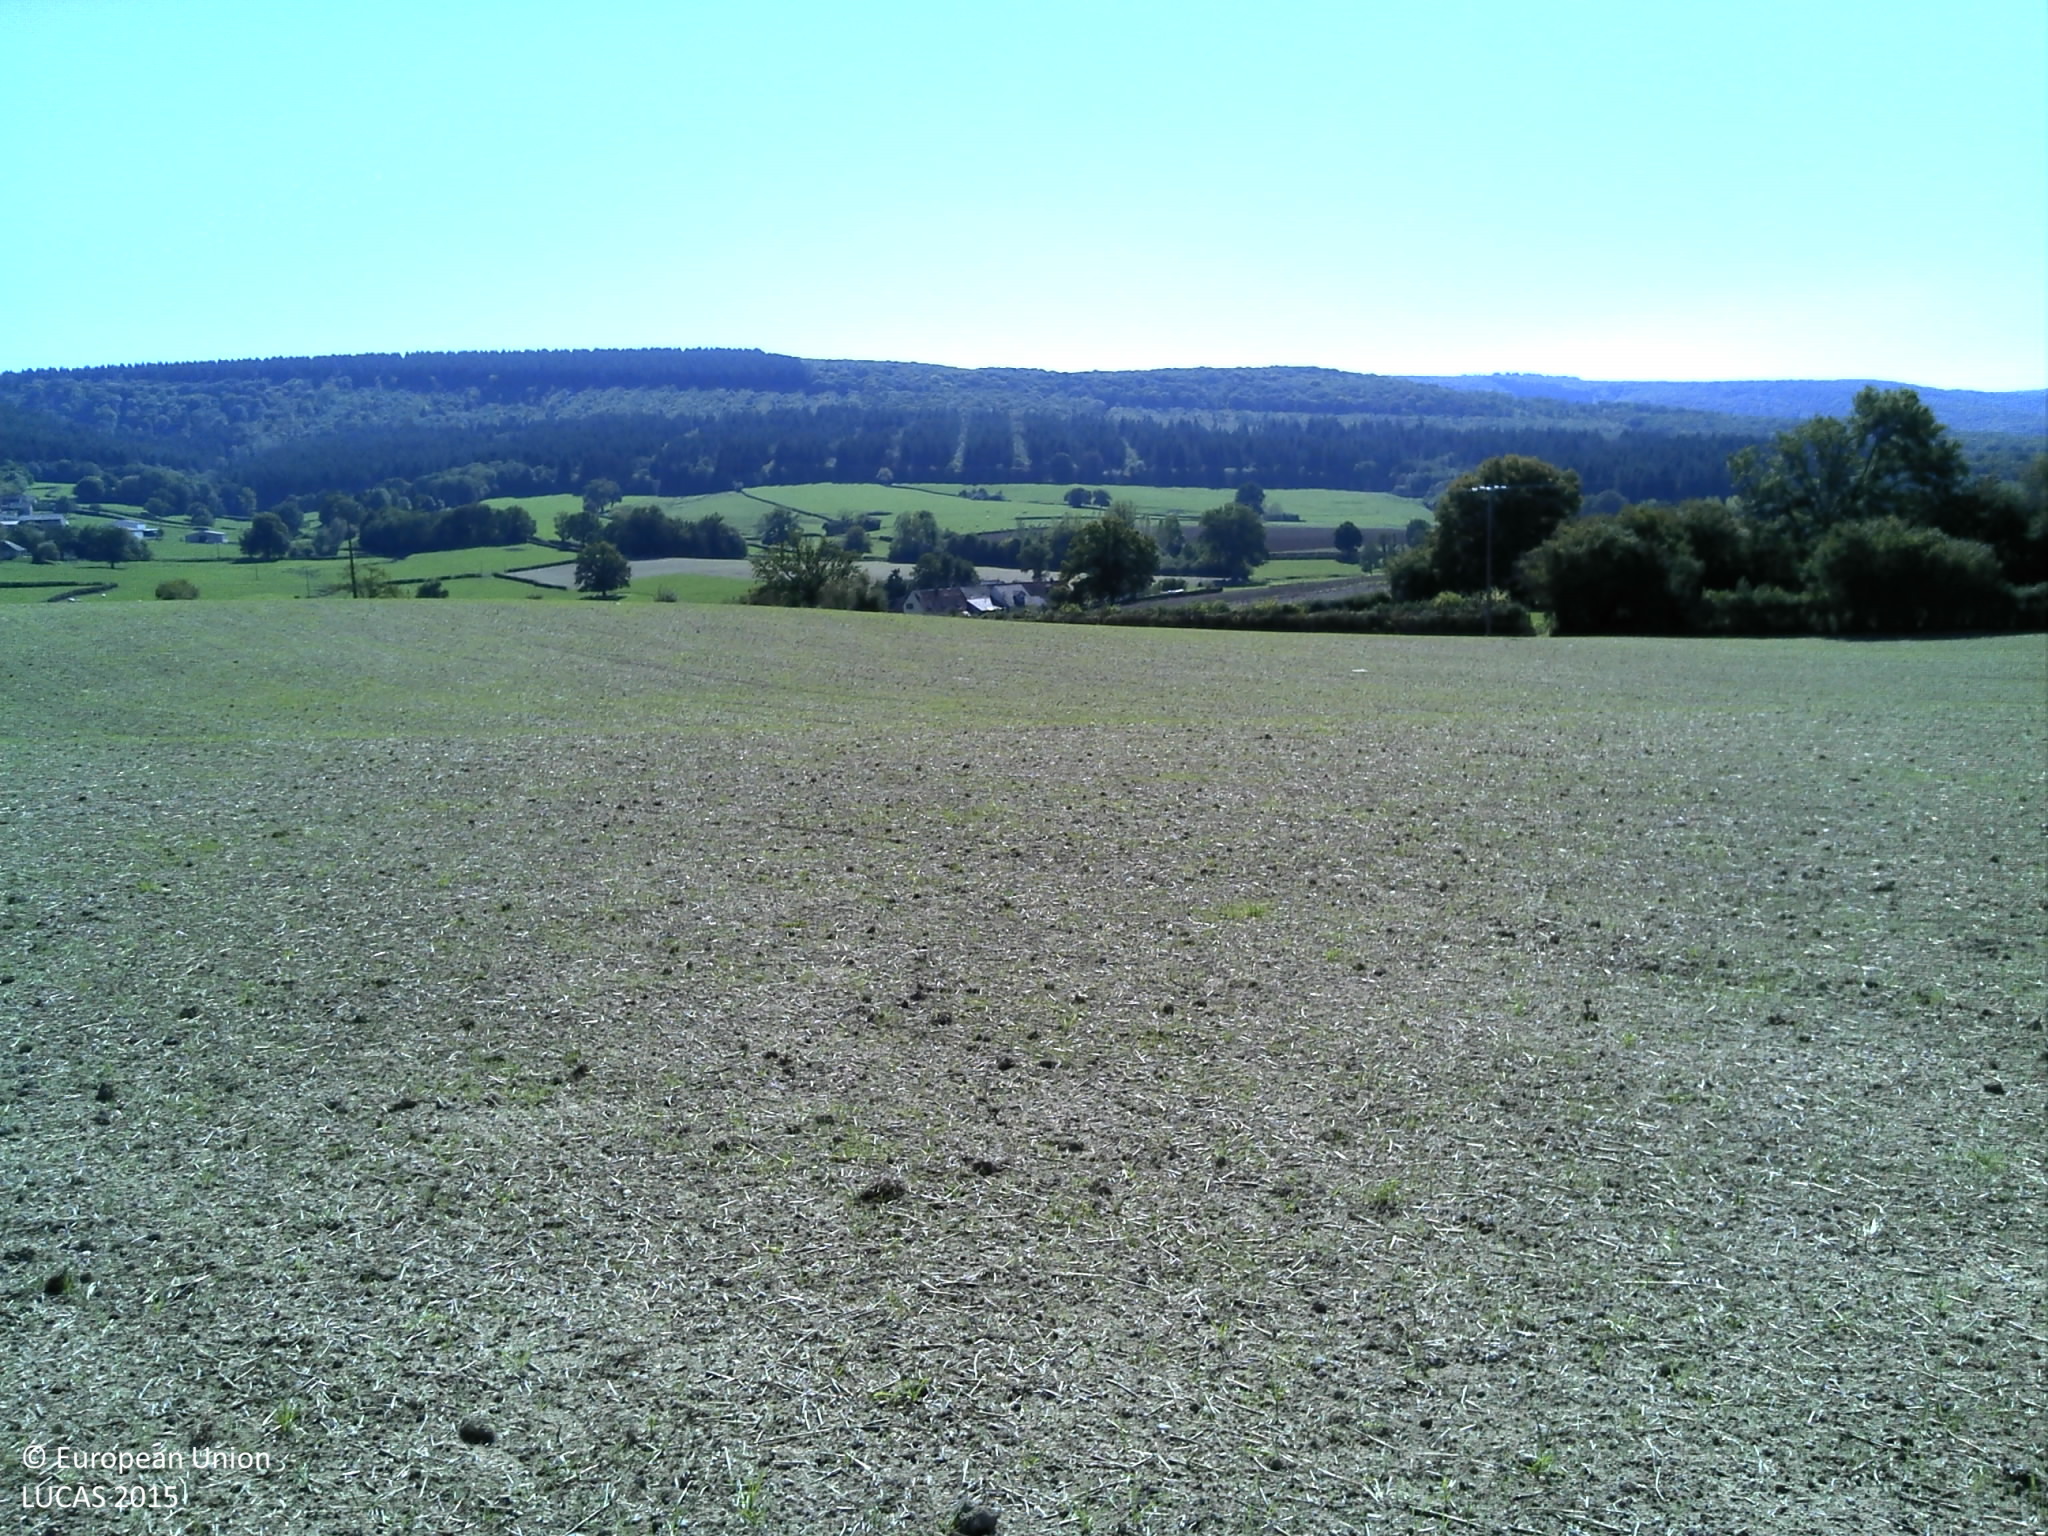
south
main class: Cropland
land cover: Common wheat
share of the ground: < 10 %
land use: Agriculture (excluding fallow land and kitchen gardens)
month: September
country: FR
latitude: 46.9786
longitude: 4.3603
